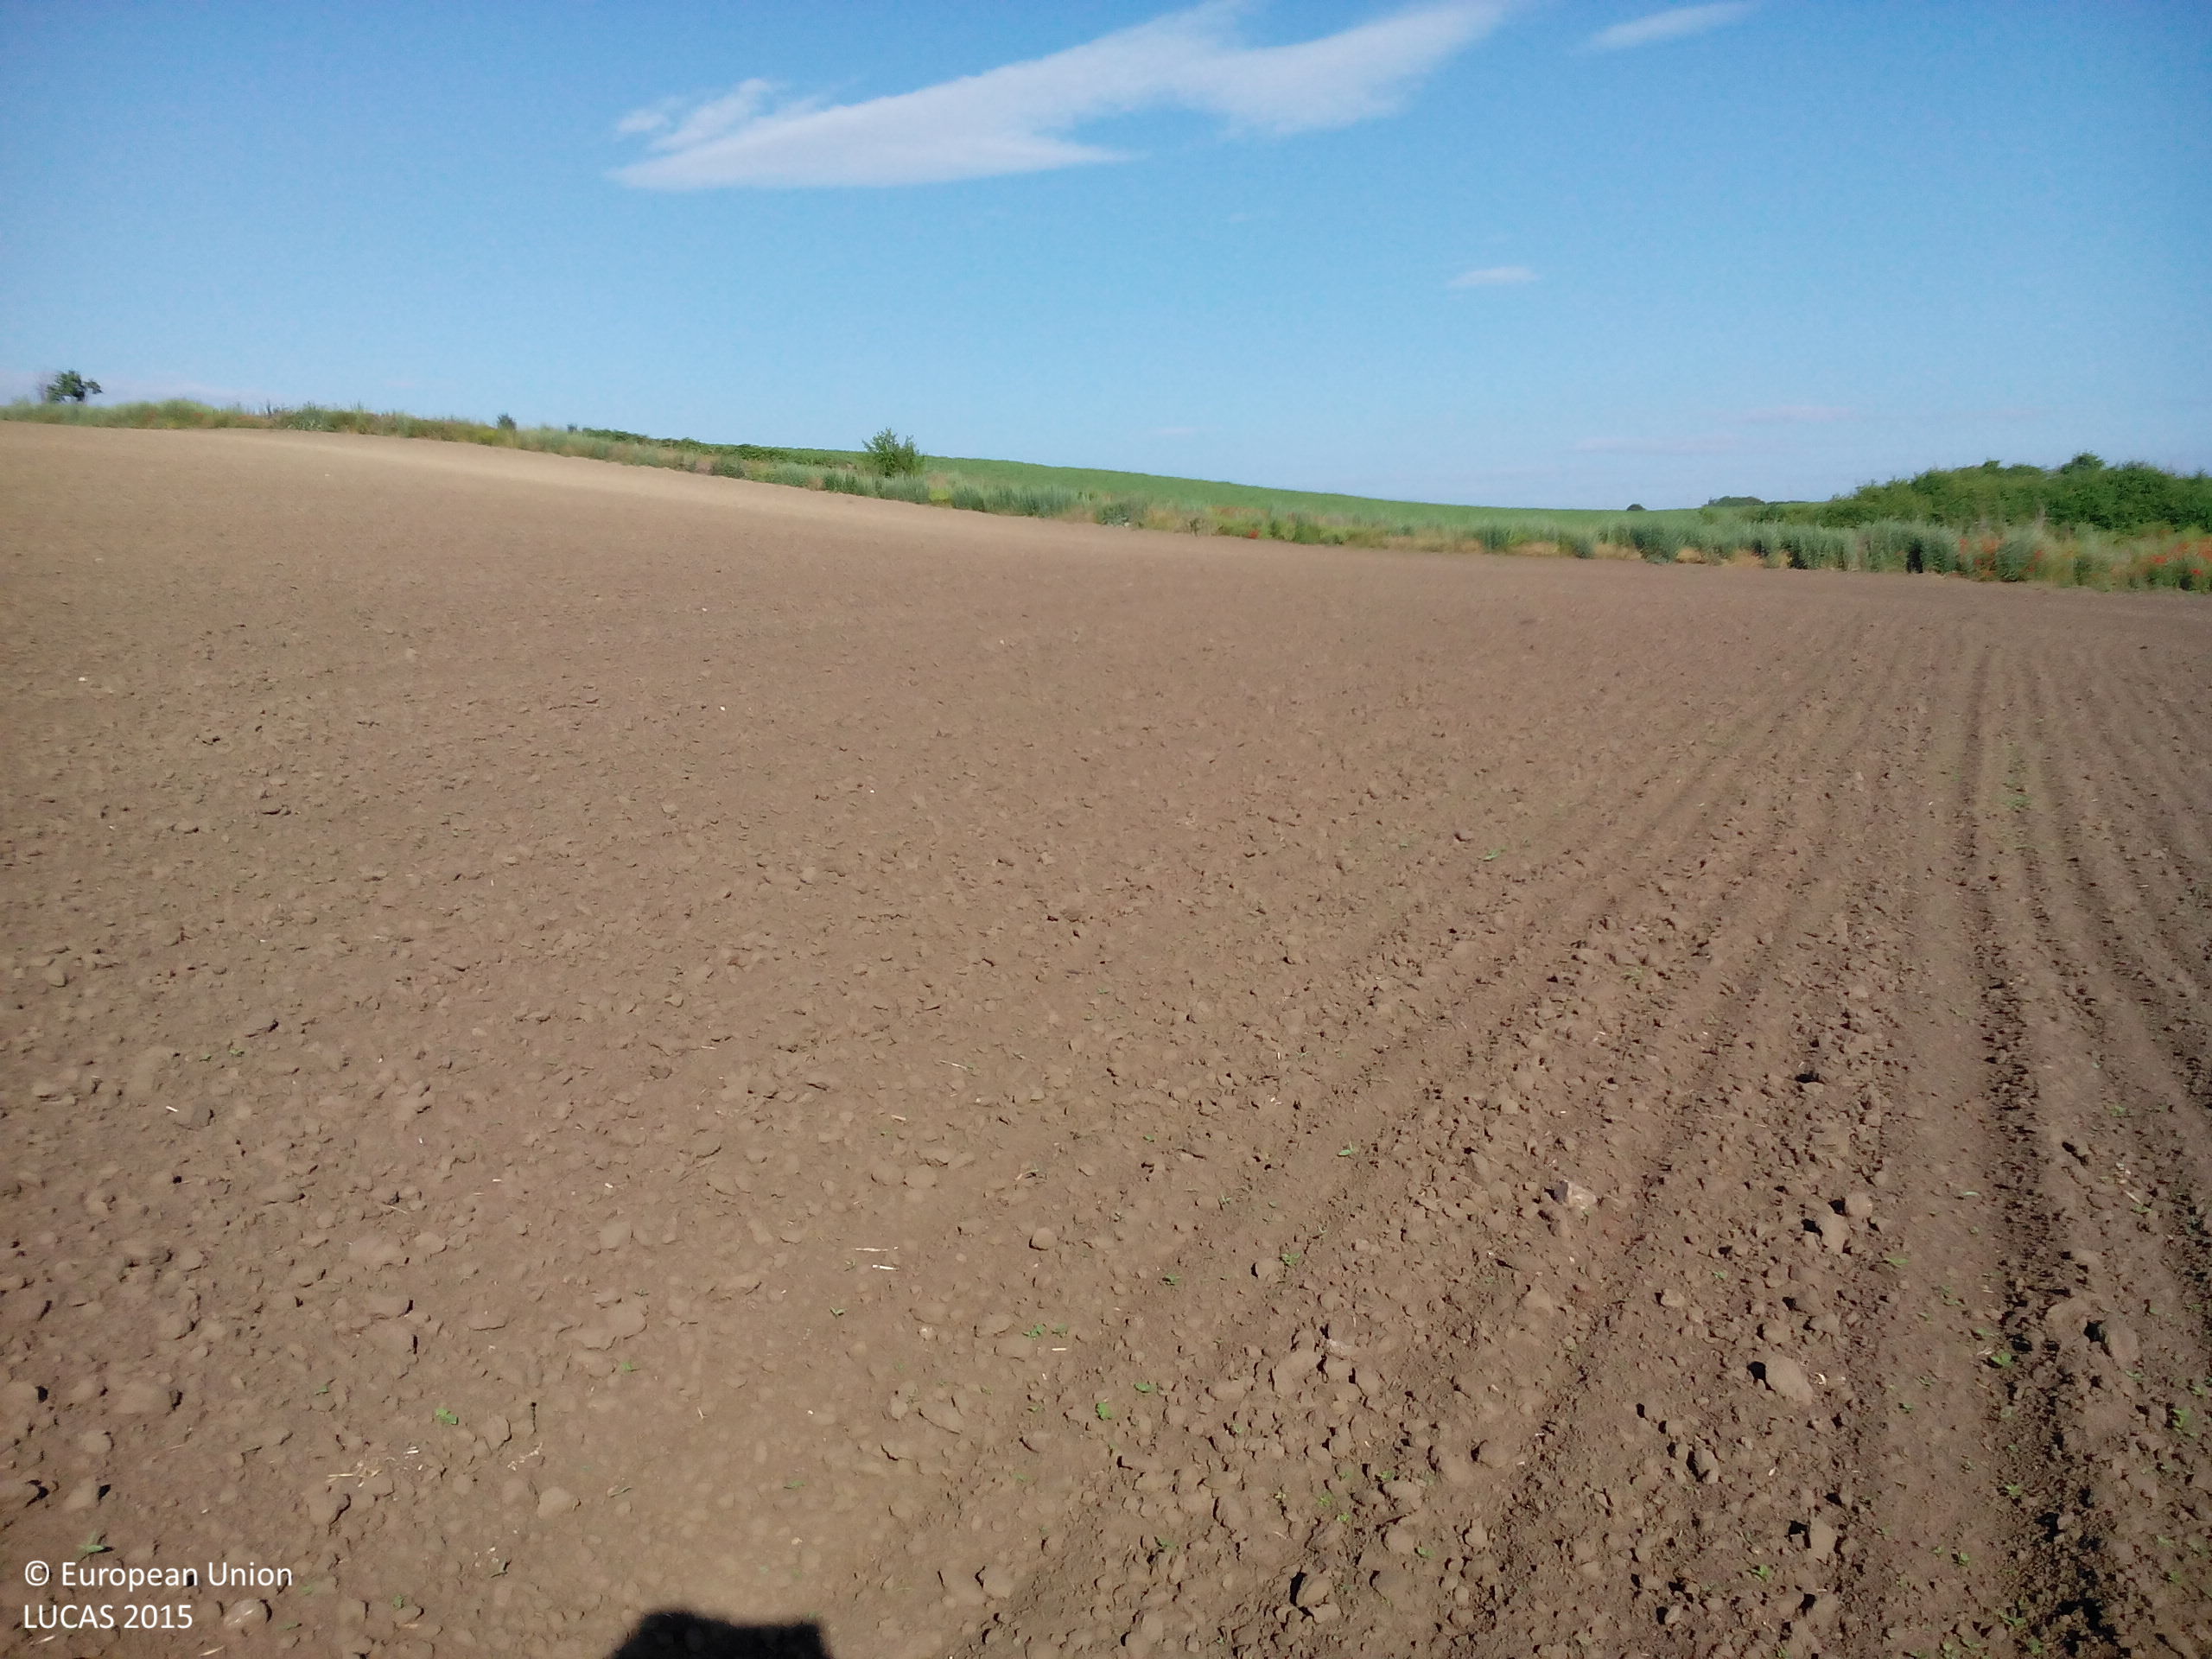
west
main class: Cropland
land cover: Sunflower
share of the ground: < 10 %
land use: Agriculture (excluding fallow land and kitchen gardens)
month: May
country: BG
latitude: 43.6634
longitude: 24.1822
